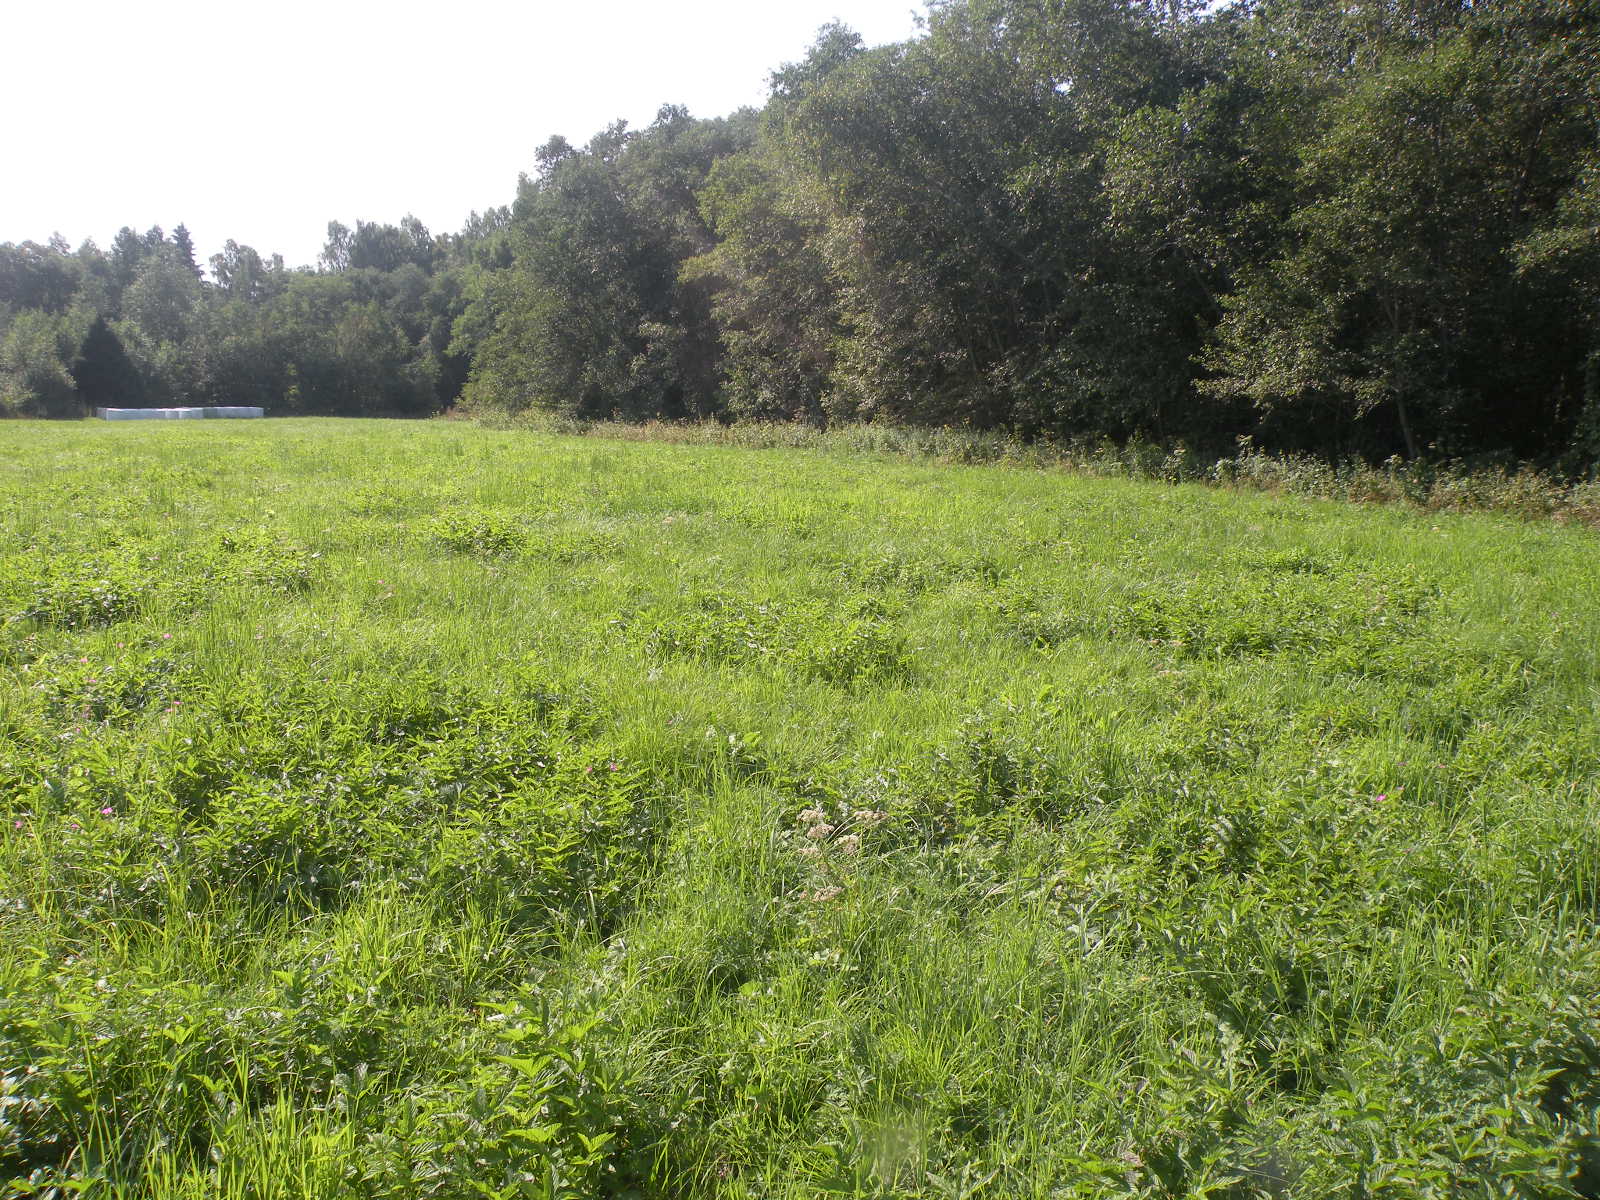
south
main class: Grassland
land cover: Grassland without tree/shrub cover
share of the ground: > 75 %
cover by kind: herbaceous plants 100 %
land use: Agriculture (excluding fallow land and kitchen gardens)
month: August
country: LV
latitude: 55.9481
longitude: 26.2690
